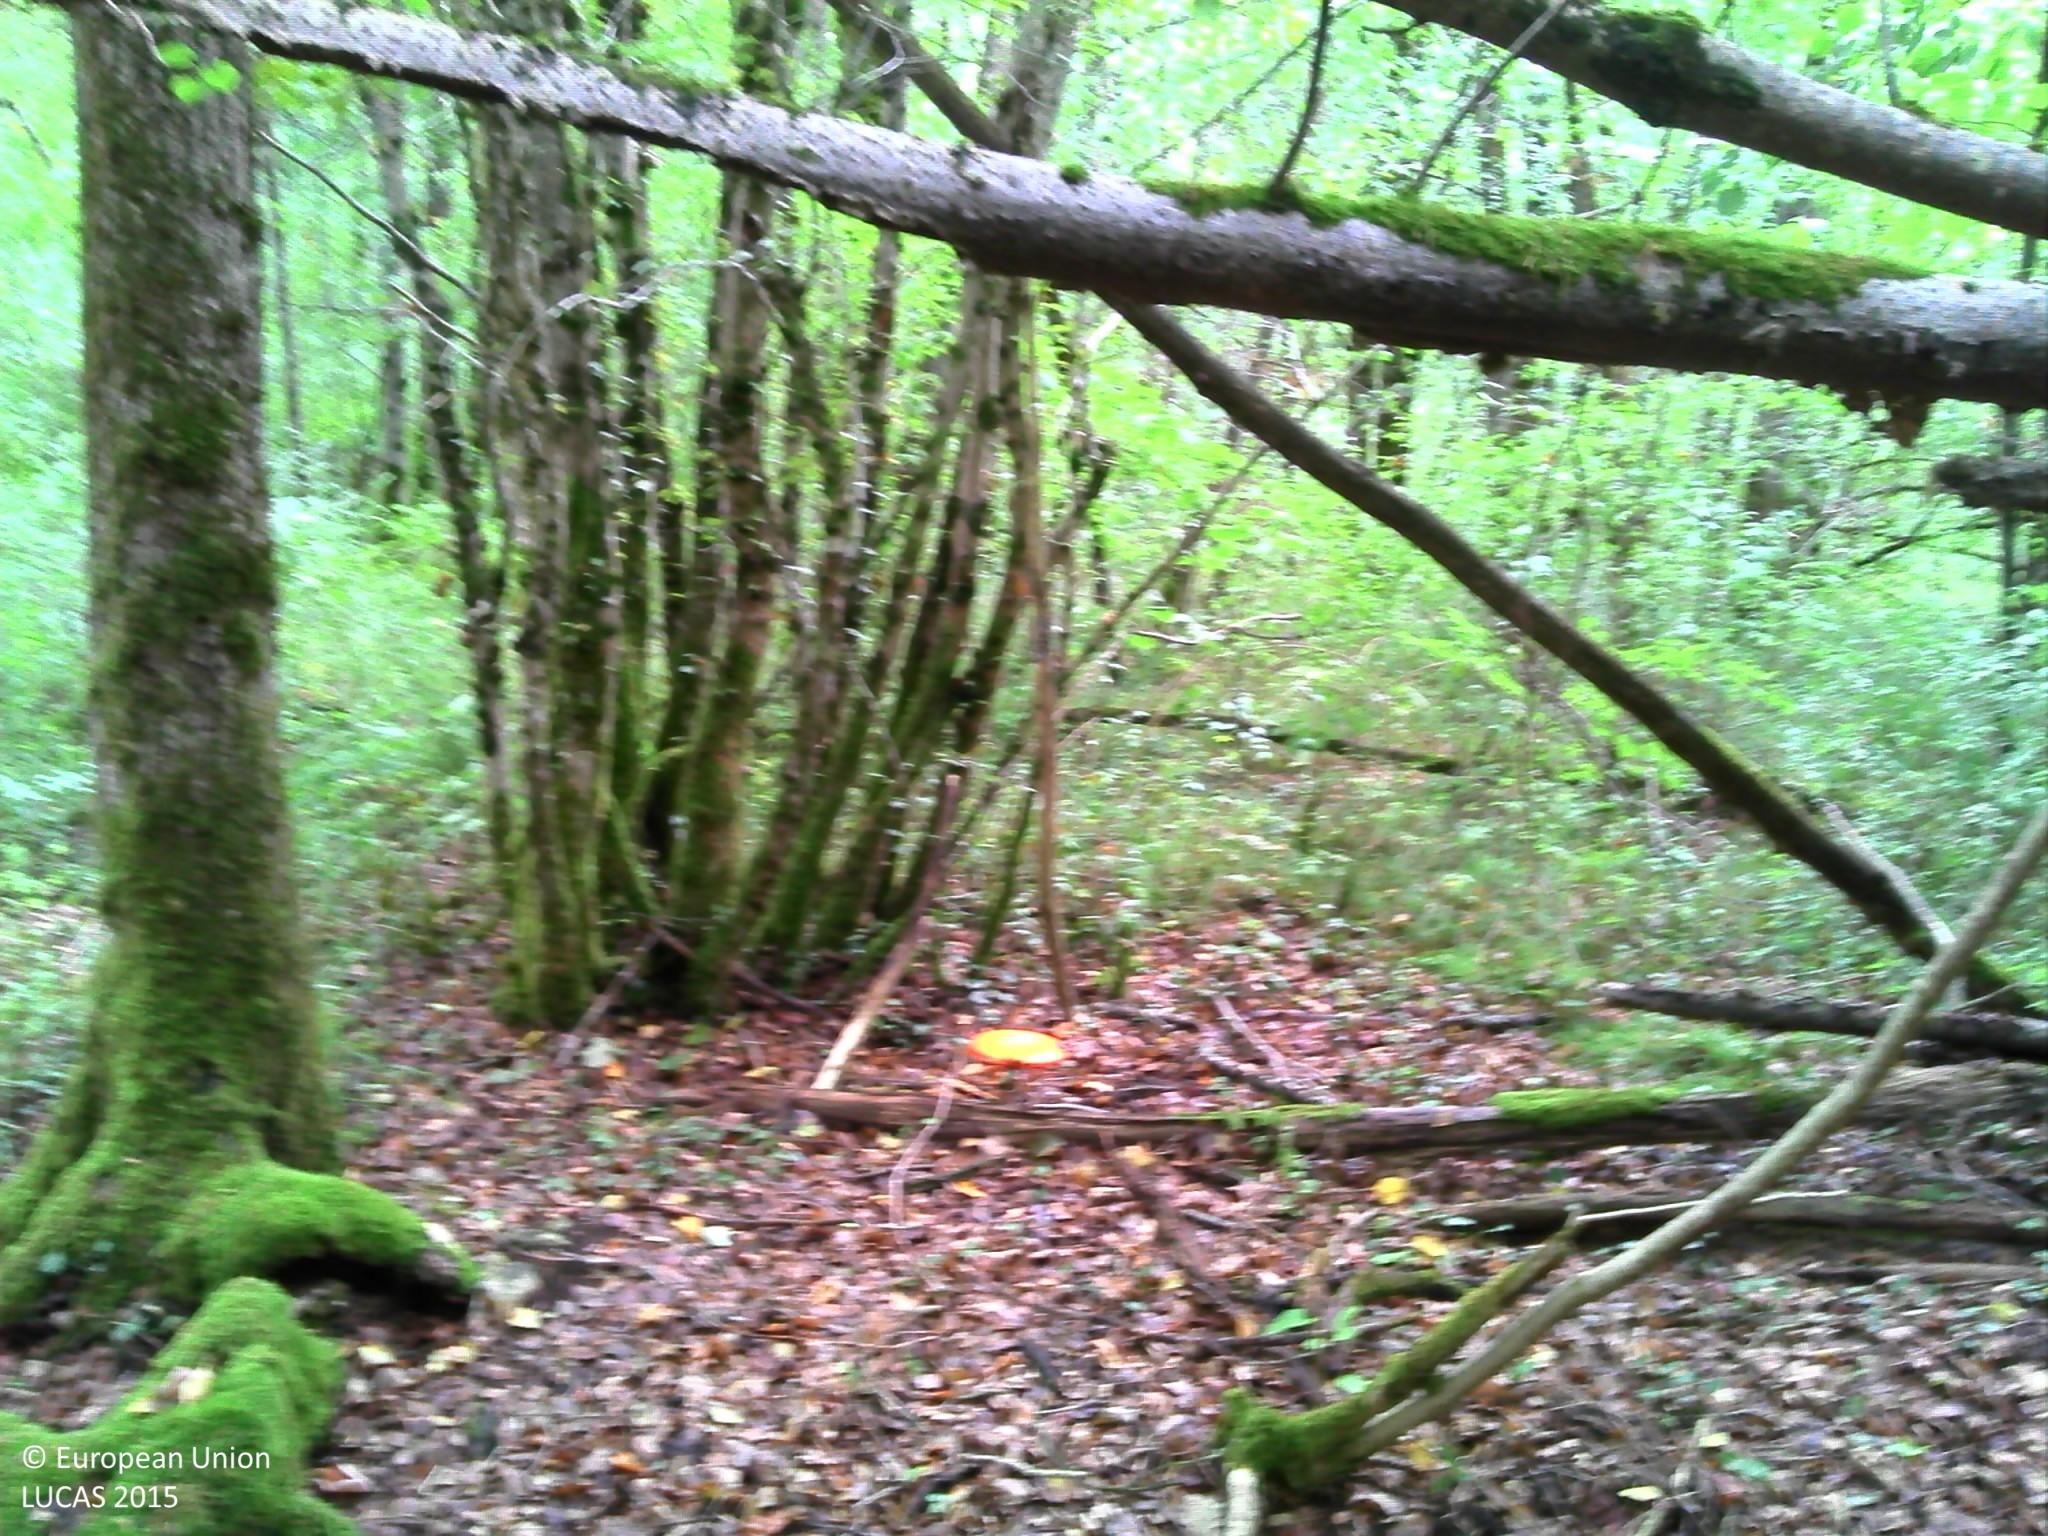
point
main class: Woodland
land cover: Broadleaved woodland
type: mesophytic deciduous forest
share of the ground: > 75 %
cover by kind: broadleaved forest trees 85 %, shrubs 5 %, herbaceous plants 5 %, lichens and mosses 5 %
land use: Forestry
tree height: > 5 m
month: August
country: FR
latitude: 47.9407
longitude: 4.8448
